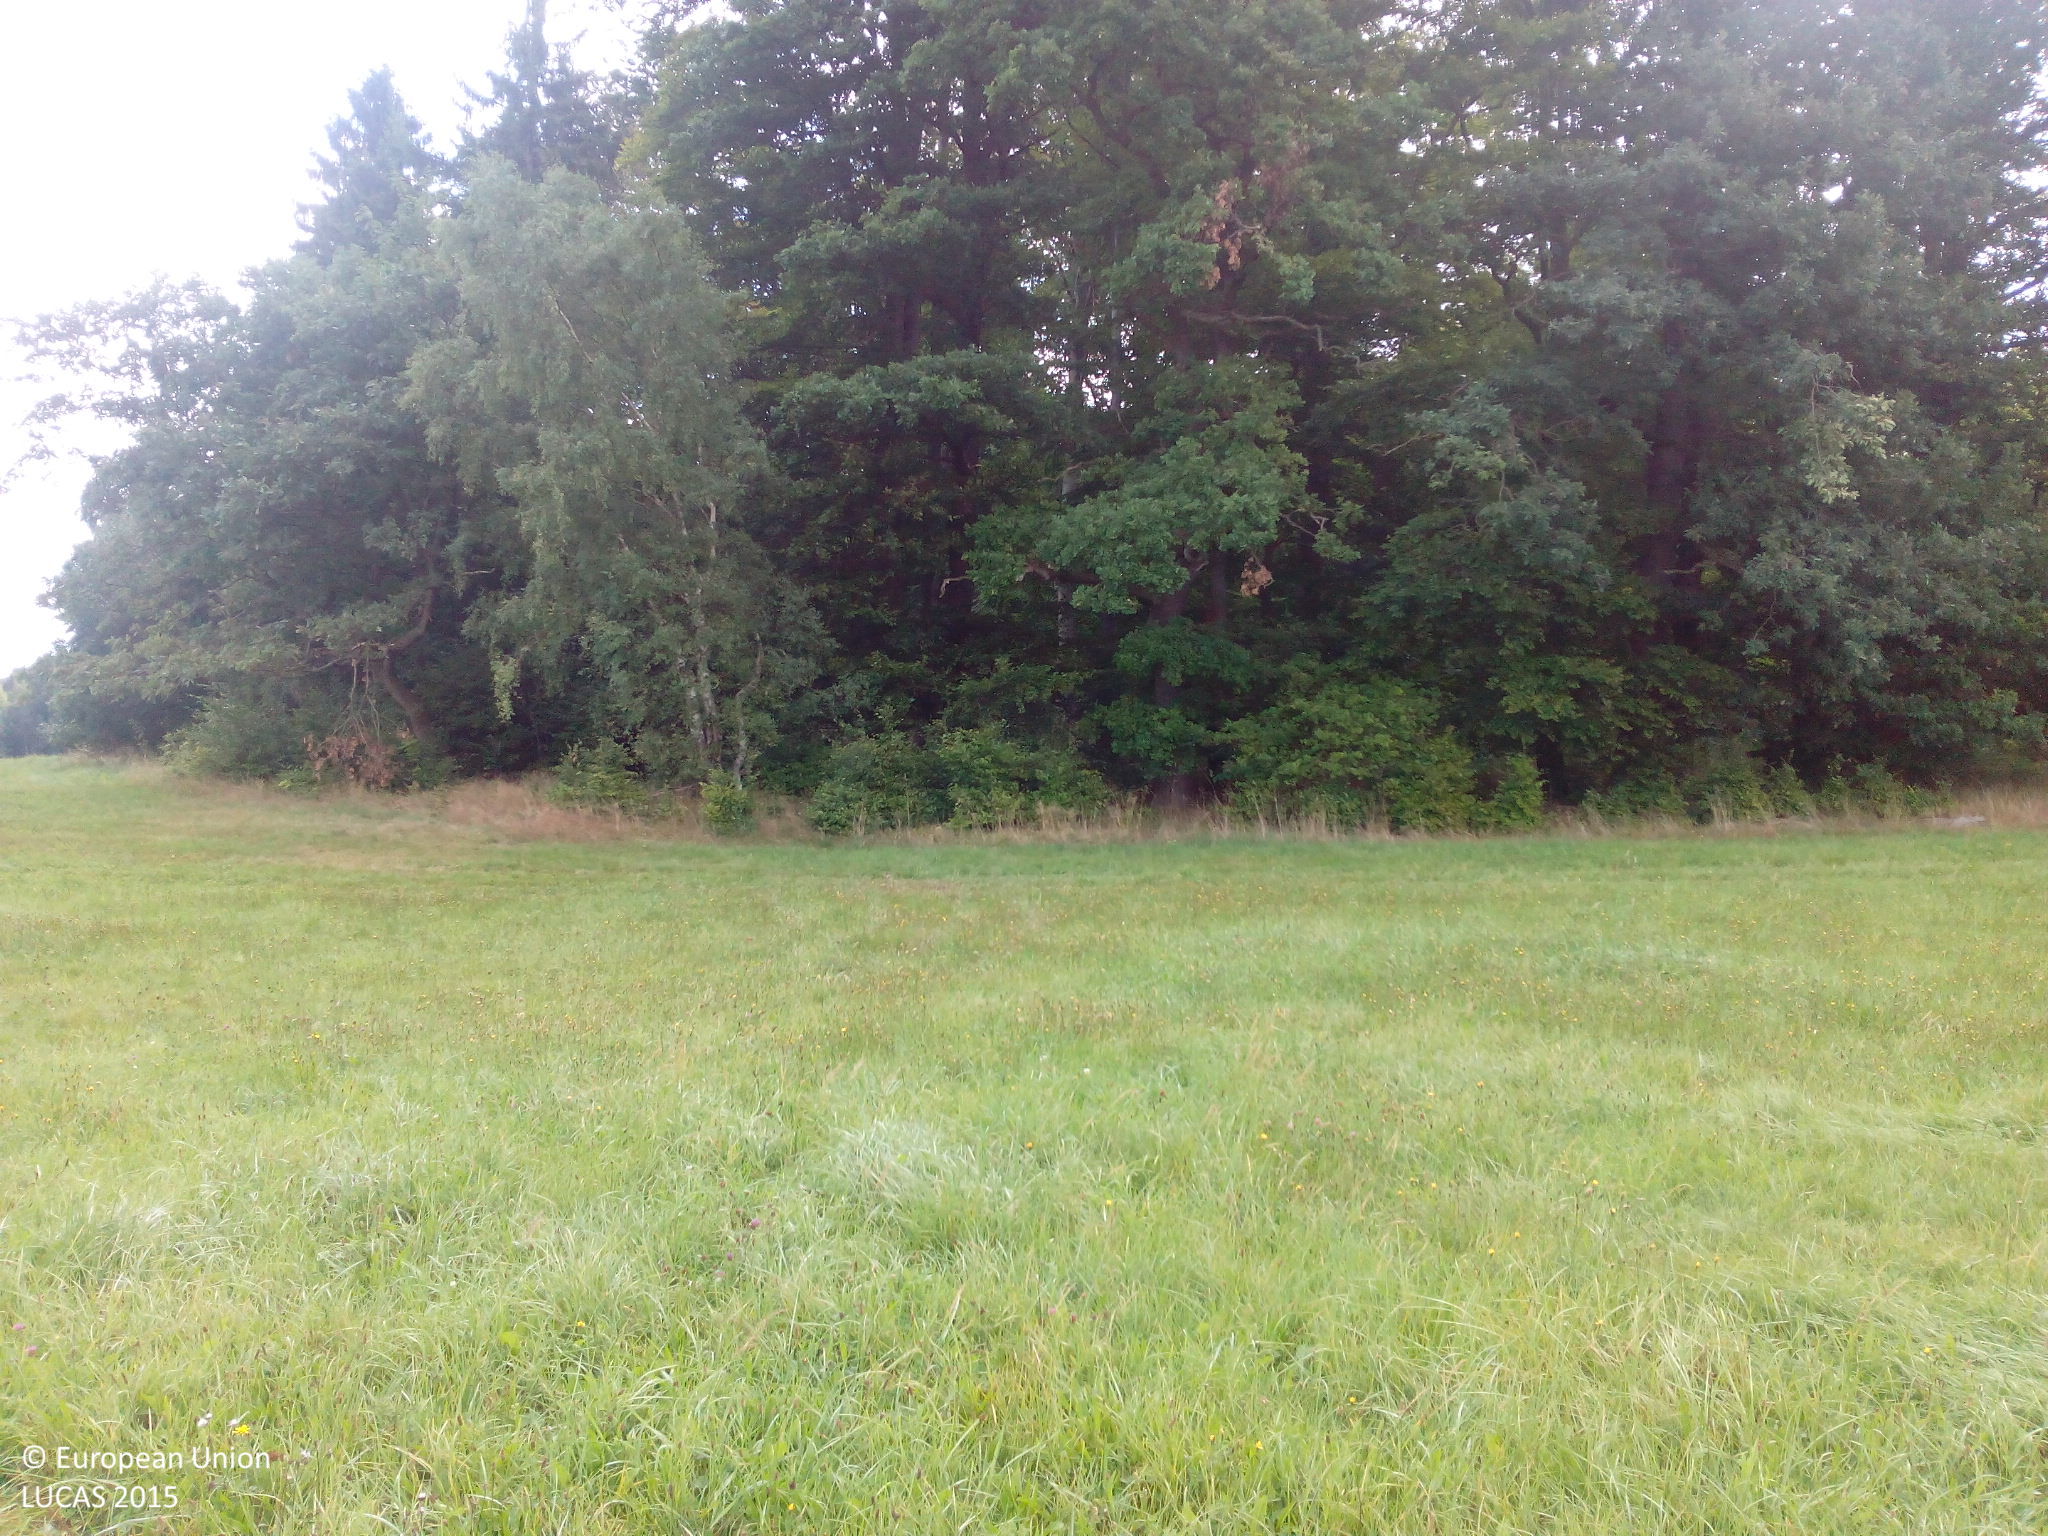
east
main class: Grassland
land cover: Grassland without tree/shrub cover
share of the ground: > 75 %
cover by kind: herbaceous plants 100 %
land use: Agriculture (excluding fallow land and kitchen gardens)
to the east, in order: Grassland without tree/shrub cover; Broadleaved woodland
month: September
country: DE
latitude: 51.5993
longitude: 11.1113
